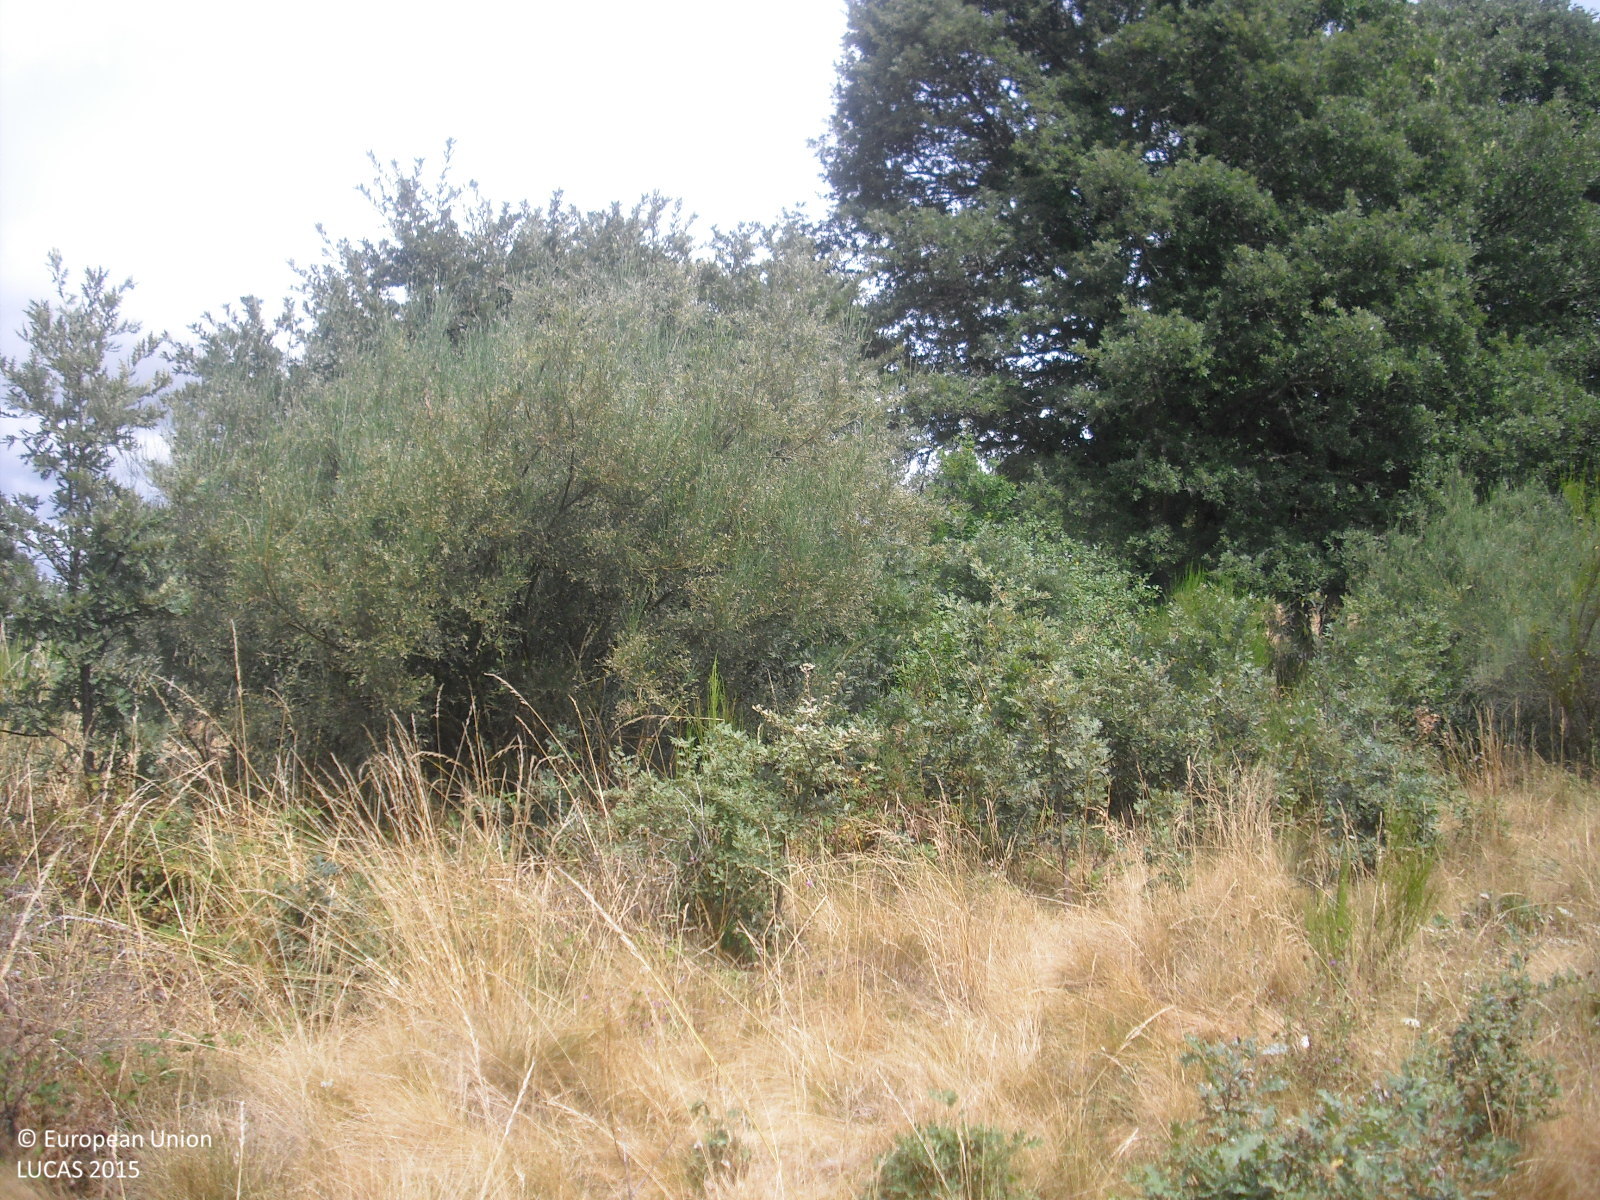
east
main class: Grassland
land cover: Grassland with sparse tree/shrub cover
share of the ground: > 75 %
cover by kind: herbaceous plants 95 %, broadleaved forest trees 5 %
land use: Abandoned areas
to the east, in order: Grassland with sparse tree/shrub cover; Shrubland with sparse tree cover; Fences; Dry stone walls; Grassland without tree/shrub cover; Ditches and canals; Grassland without tree/shrub cover; Fences; Grassland without tree/shrub cover; Shruby margins; Groves; Dry stone walls; Shruby margins; Grassland without tree/shrub cover; Electric lines; Grassland without tree/shrub cover; Shruby margins; Groves; Dry stone walls; Shruby margins; Tracks; Shruby margins; Dry stone walls; Broadleaved woodland; Shrubland with sparse tree cover
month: July
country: ES
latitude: 42.3486
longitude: -7.4118
